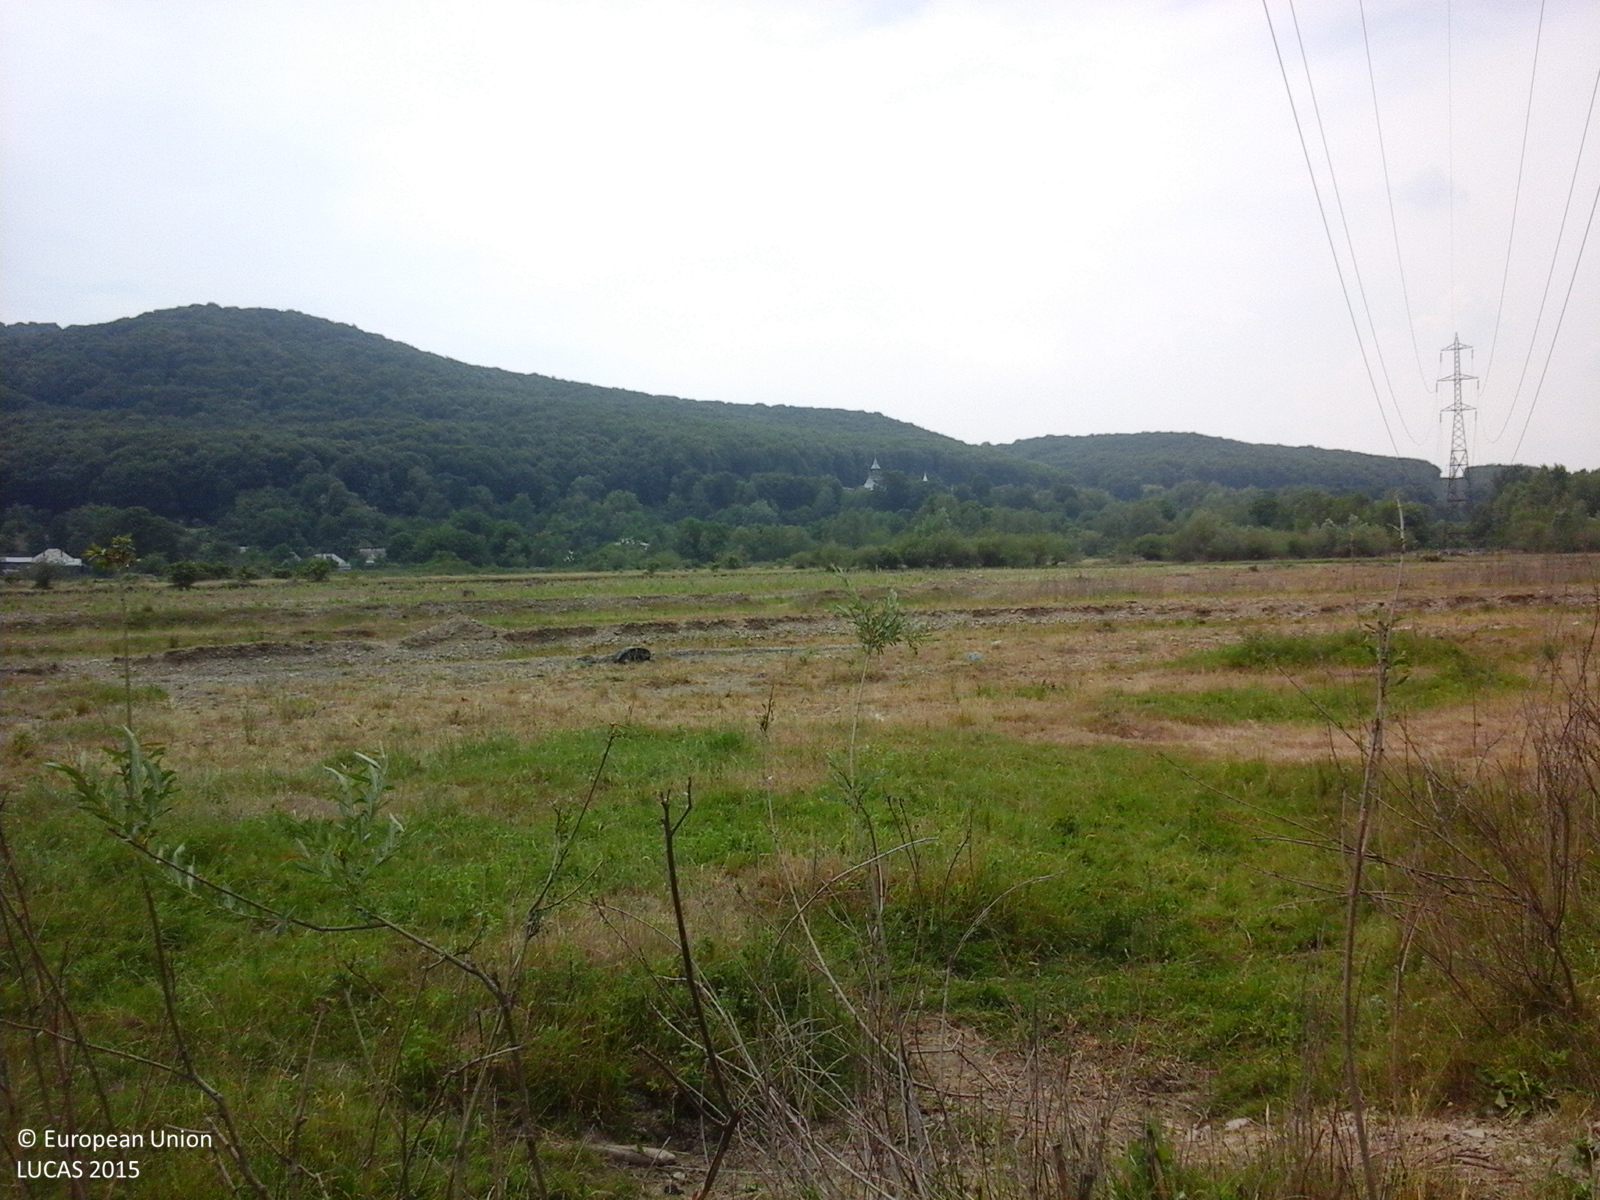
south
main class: Artificial land
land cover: Non built-up linear features
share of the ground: > 75 %
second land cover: Spontaneously vegetated surfaces
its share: > 75 %
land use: Electricity, gas and thermal power distribution
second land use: Agriculture (excluding fallow land and kitchen gardens)
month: June
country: RO
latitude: 47.2023
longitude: 26.4142
